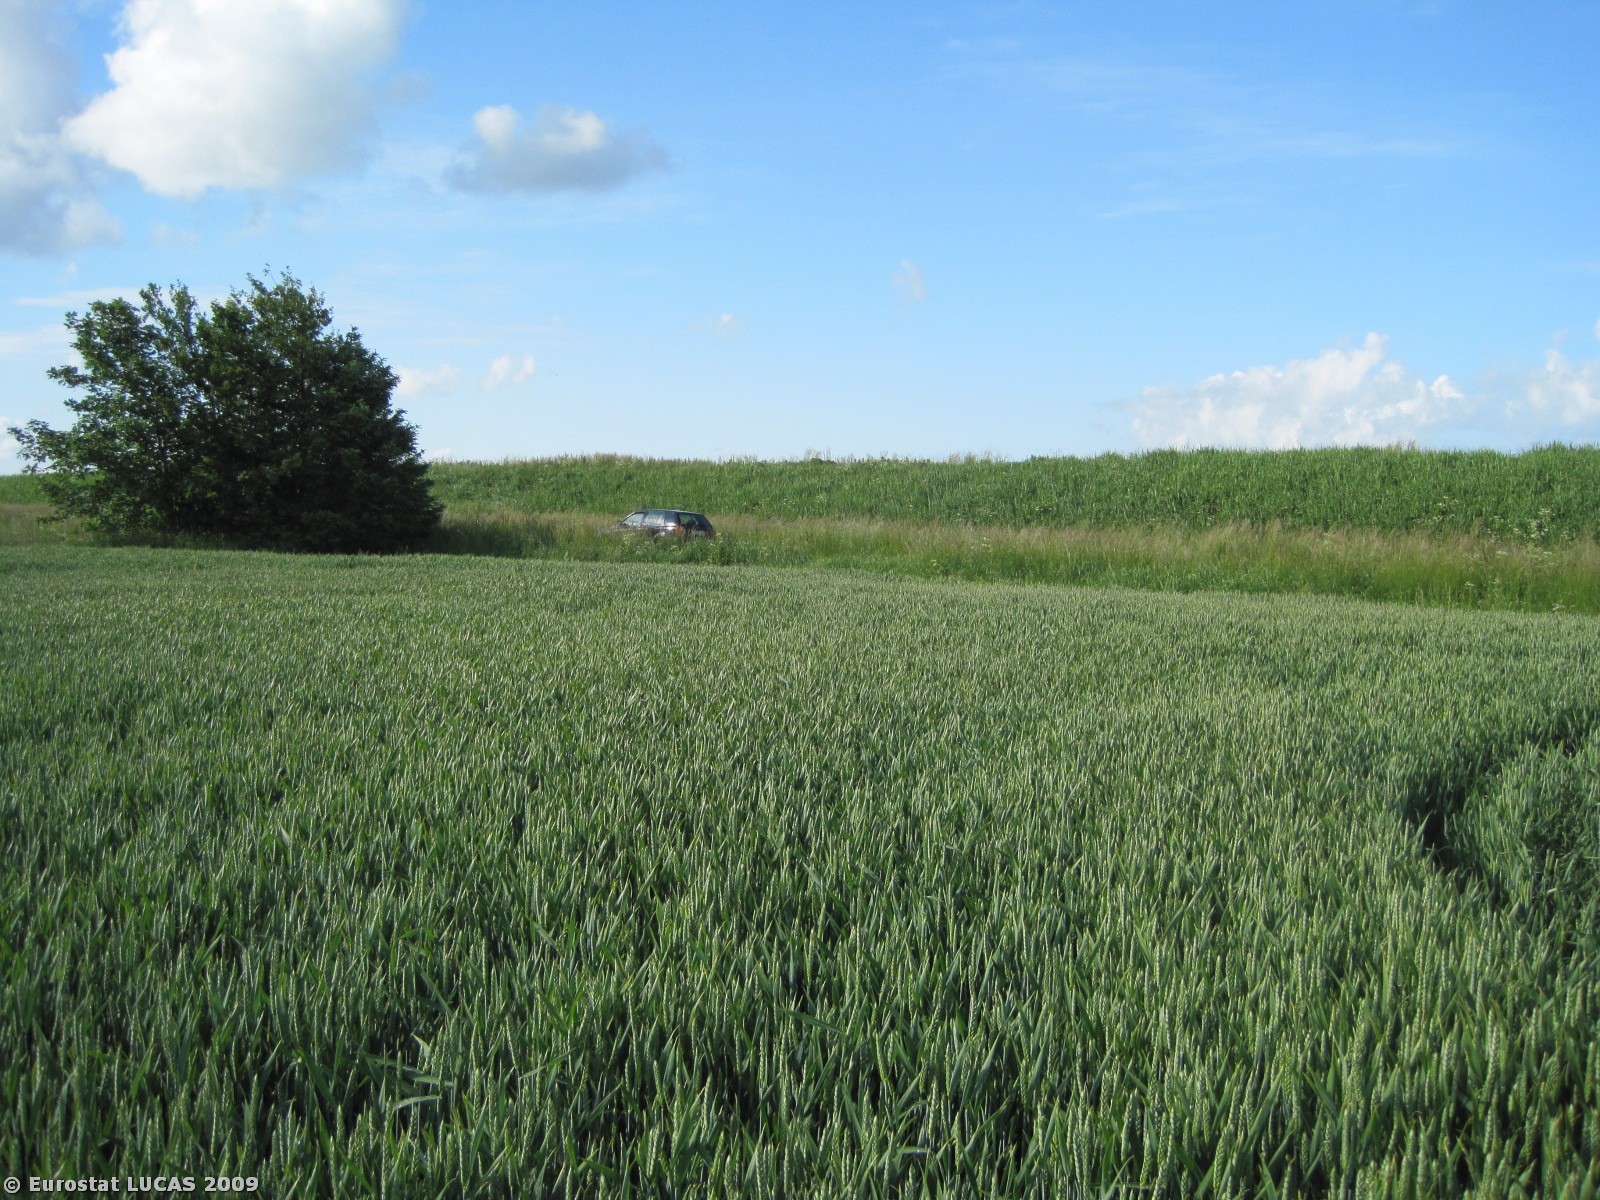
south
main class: Cropland
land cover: Common wheat
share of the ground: > 75 %
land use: Agriculture (excluding fallow land and kitchen gardens)
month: June
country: DK
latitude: 57.0506
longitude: 10.1152
